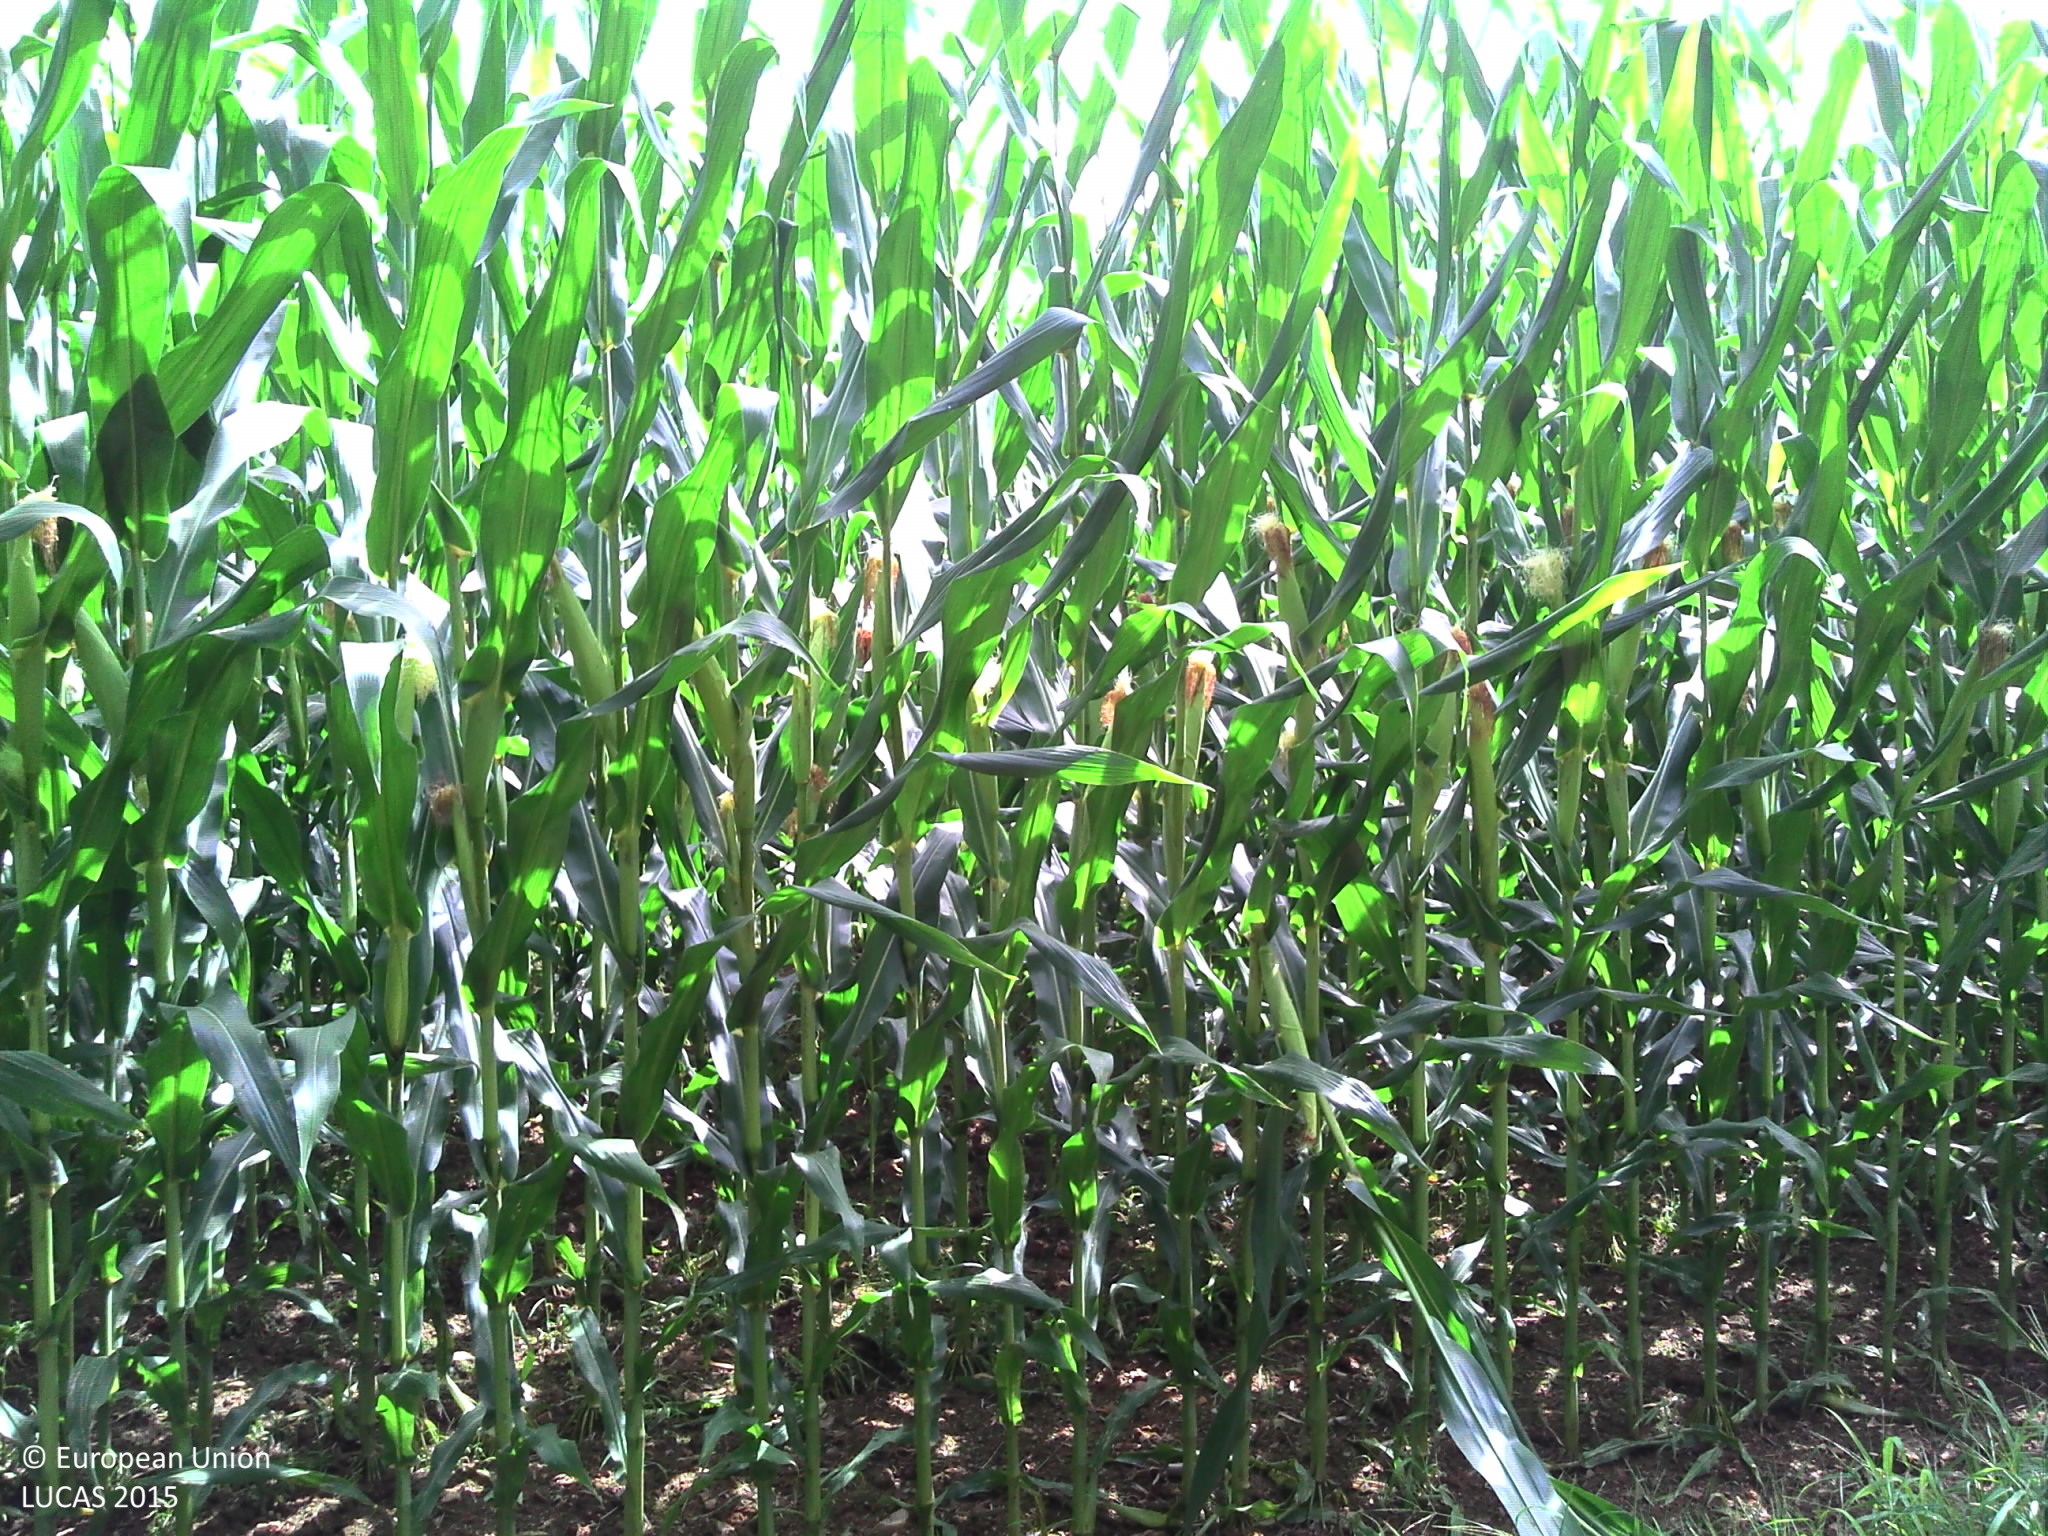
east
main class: Cropland
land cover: Maize
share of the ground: > 75 %
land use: Agriculture (excluding fallow land and kitchen gardens)
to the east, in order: Maize; Grass margins; Broadleaved woodland
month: July
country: FR
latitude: 46.3781
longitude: 0.2693
